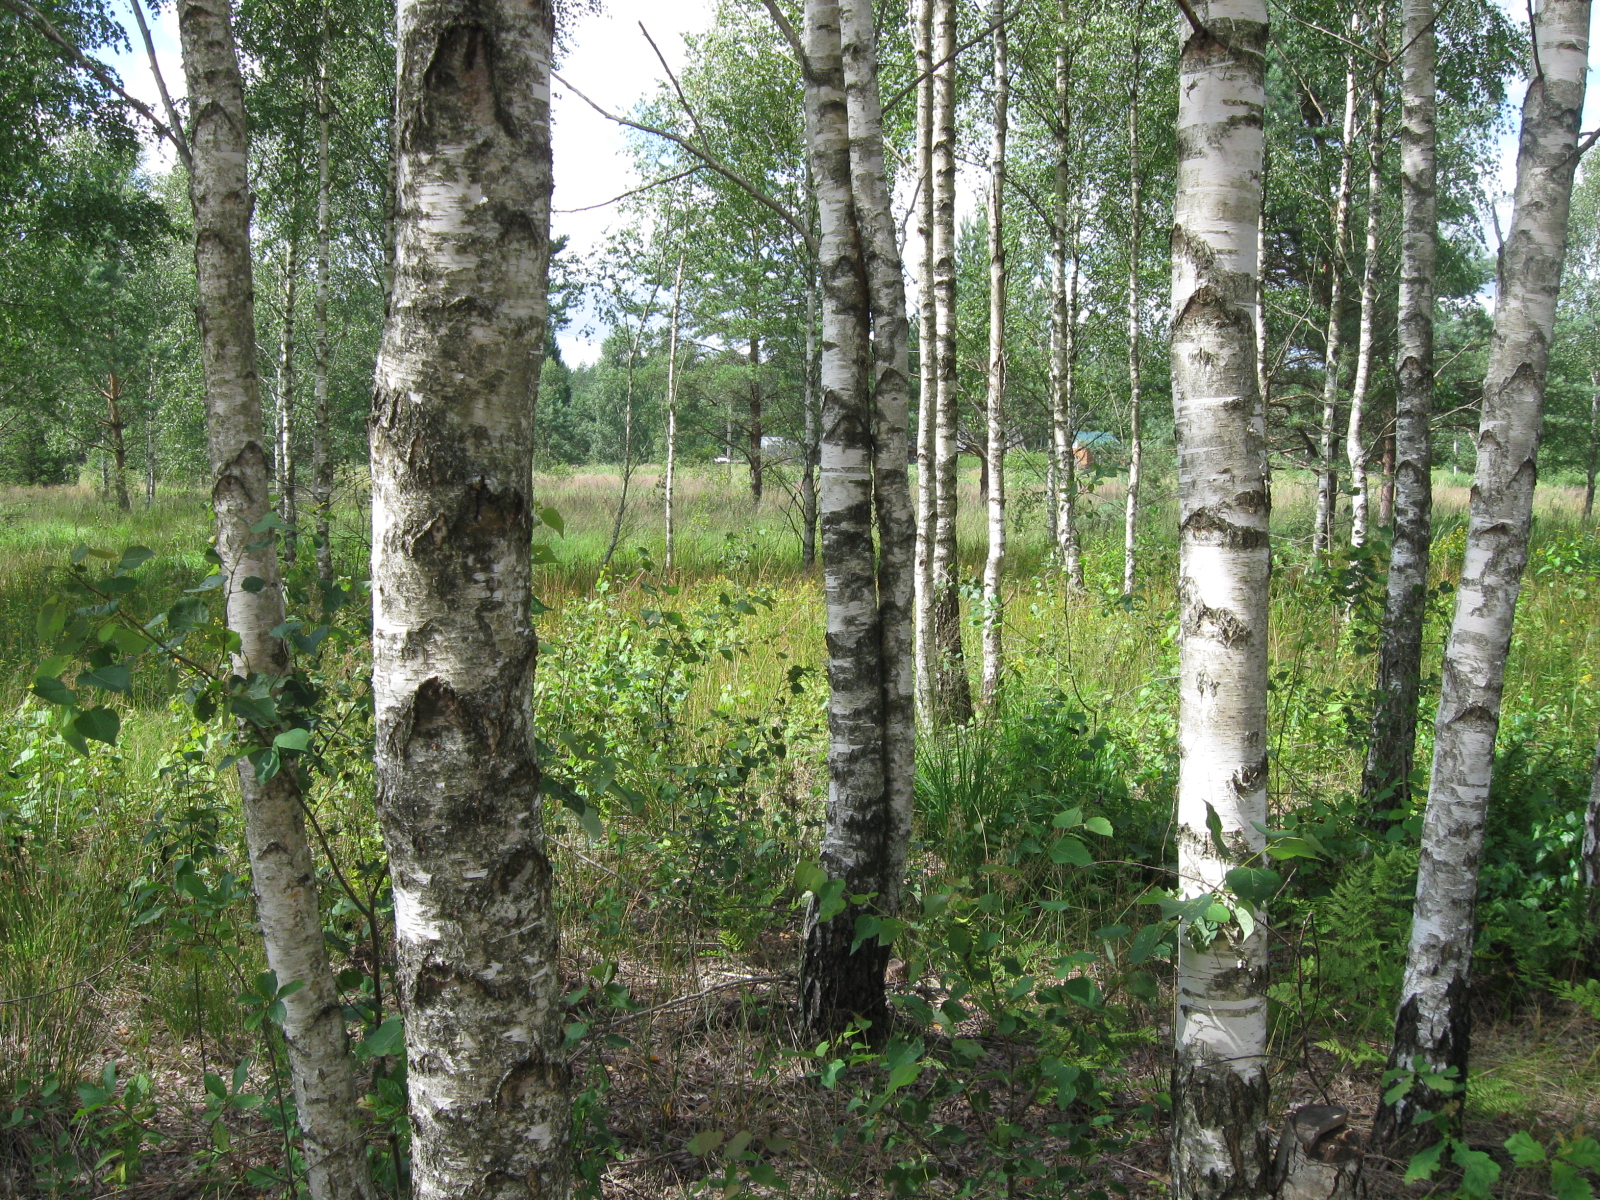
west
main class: Woodland
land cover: Pine dominated mixed woodland
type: hemiboreal forest and nemoral coniferous forest and mixed broadleaved-coniferous forest
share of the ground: 50 - 75 %
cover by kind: broadleaved forest trees 35 %, coniferous forest trees 25 %, herbaceous plants 25 %, unconsolidated bare surface 10 %, lichens and mosses 5 %
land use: Forestry
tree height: < 5 m
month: July
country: LT
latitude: 54.9692
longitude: 23.4036
